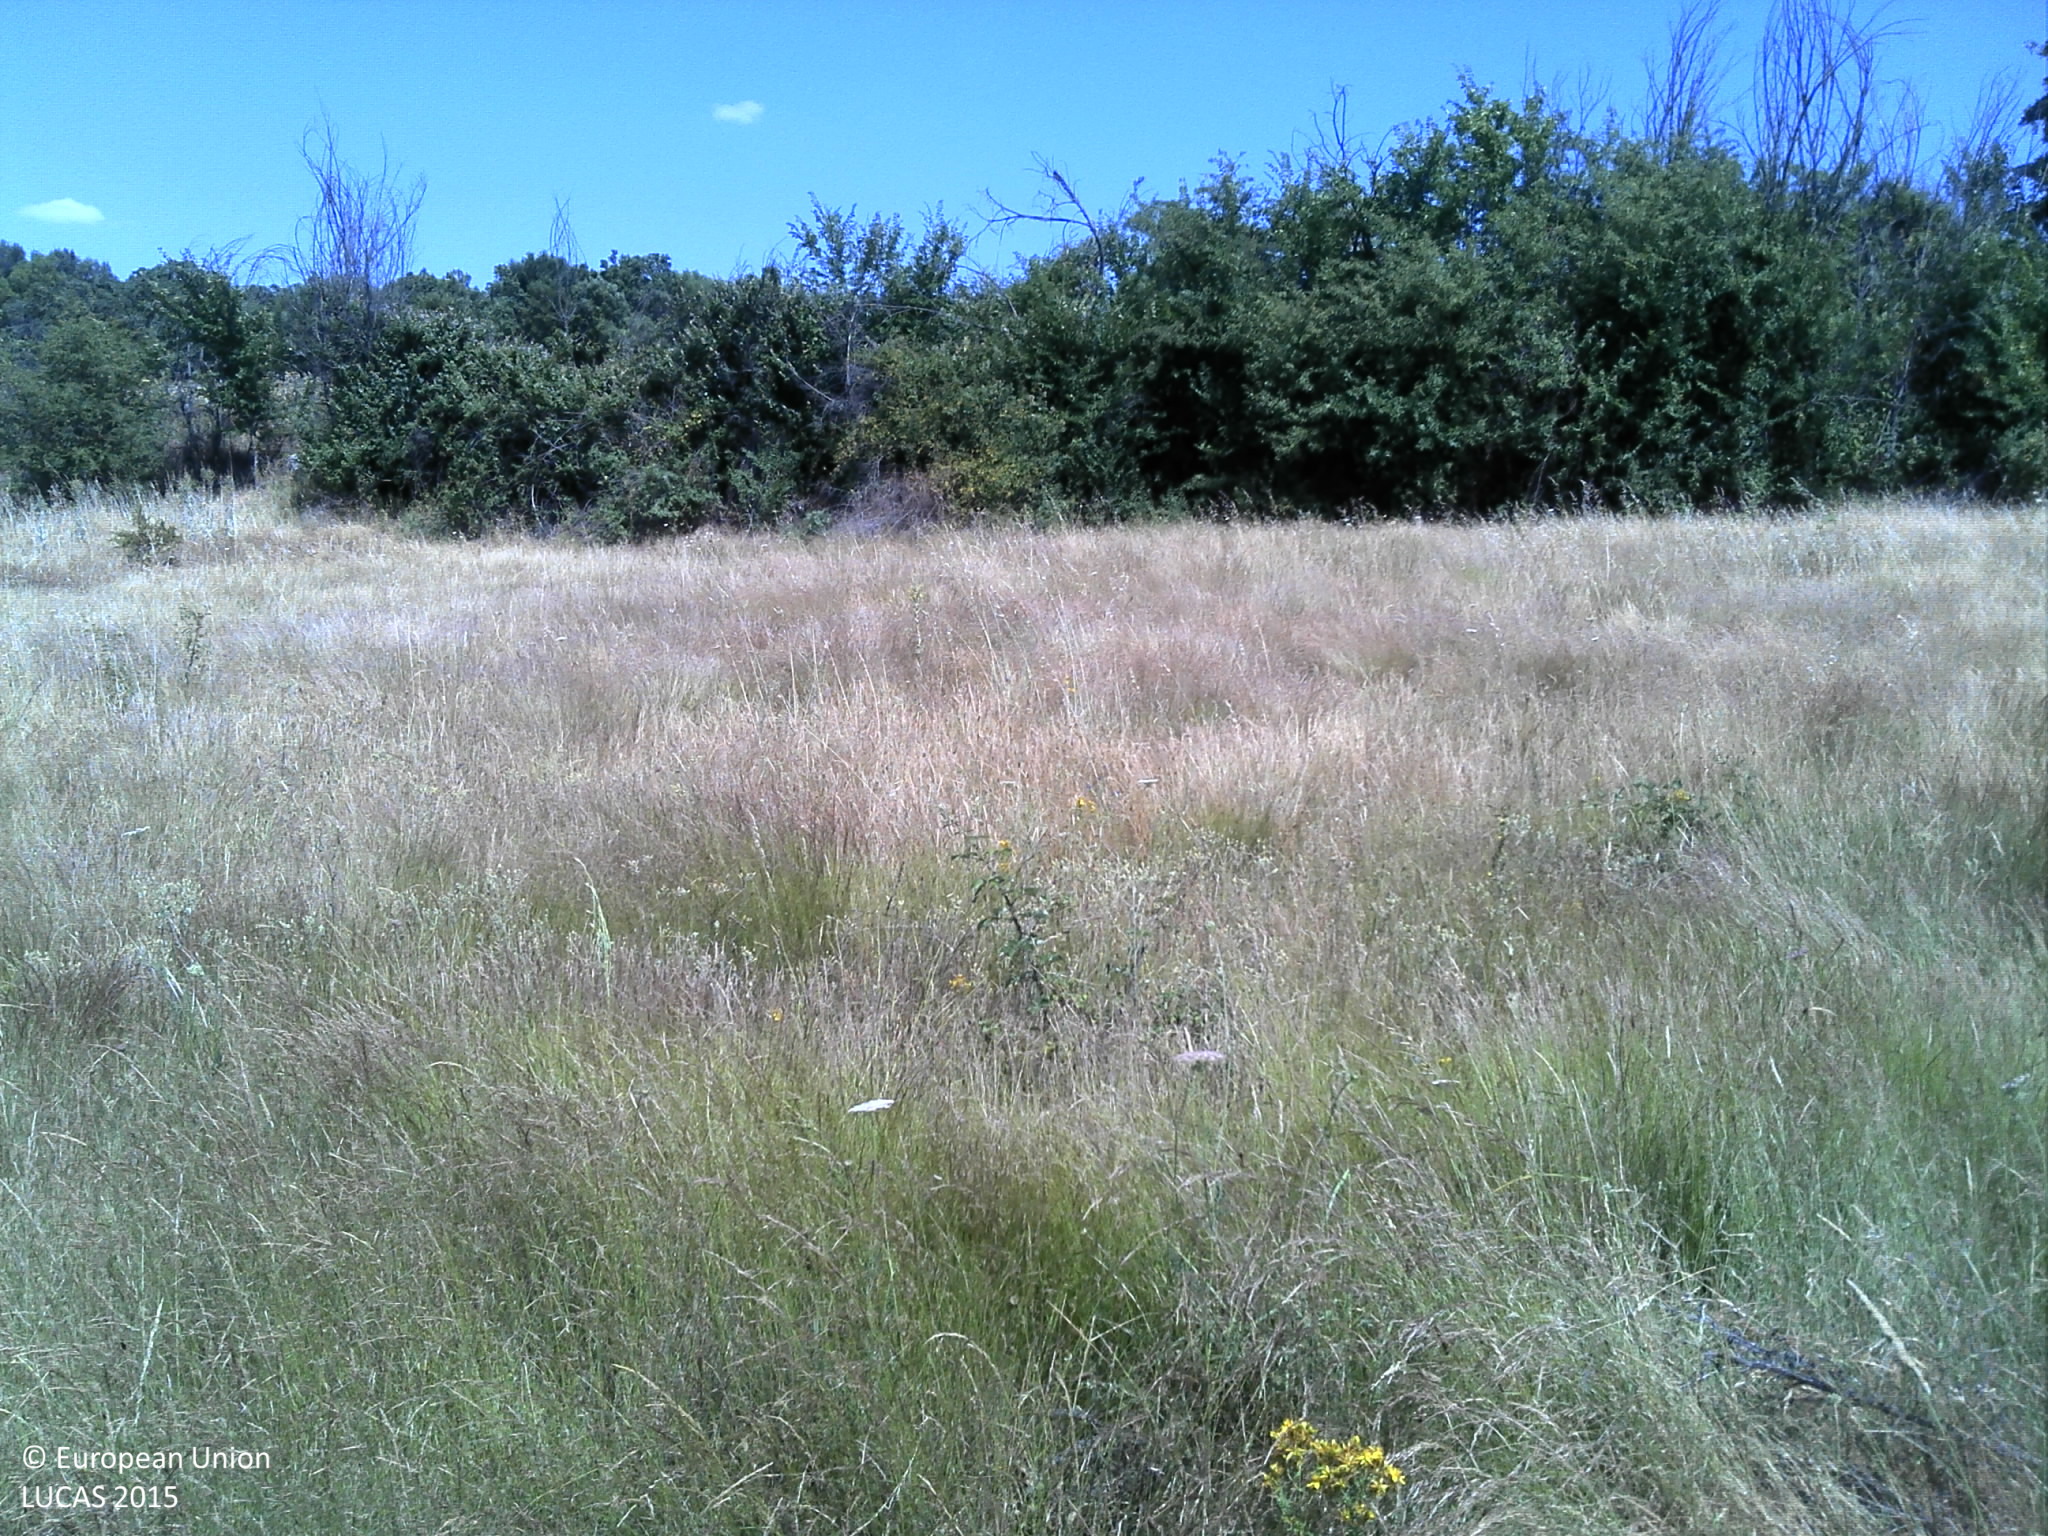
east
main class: Grassland
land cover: Grassland without tree/shrub cover
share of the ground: > 75 %
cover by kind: herbaceous plants 100 %
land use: Agriculture (excluding fallow land and kitchen gardens)
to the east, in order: Grassland without tree/shrub cover; Shruby margins; Dry stone walls; Abandoned hedges; Fences; Tracks; Shruby margins; Fences; Rye; Dry stone walls; Abandoned hedges; Tracks; Spontaneously vegetated surfaces; Tracks; Broadleaved woodland; Oats
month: June
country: PT
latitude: 40.8691
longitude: -6.9156
